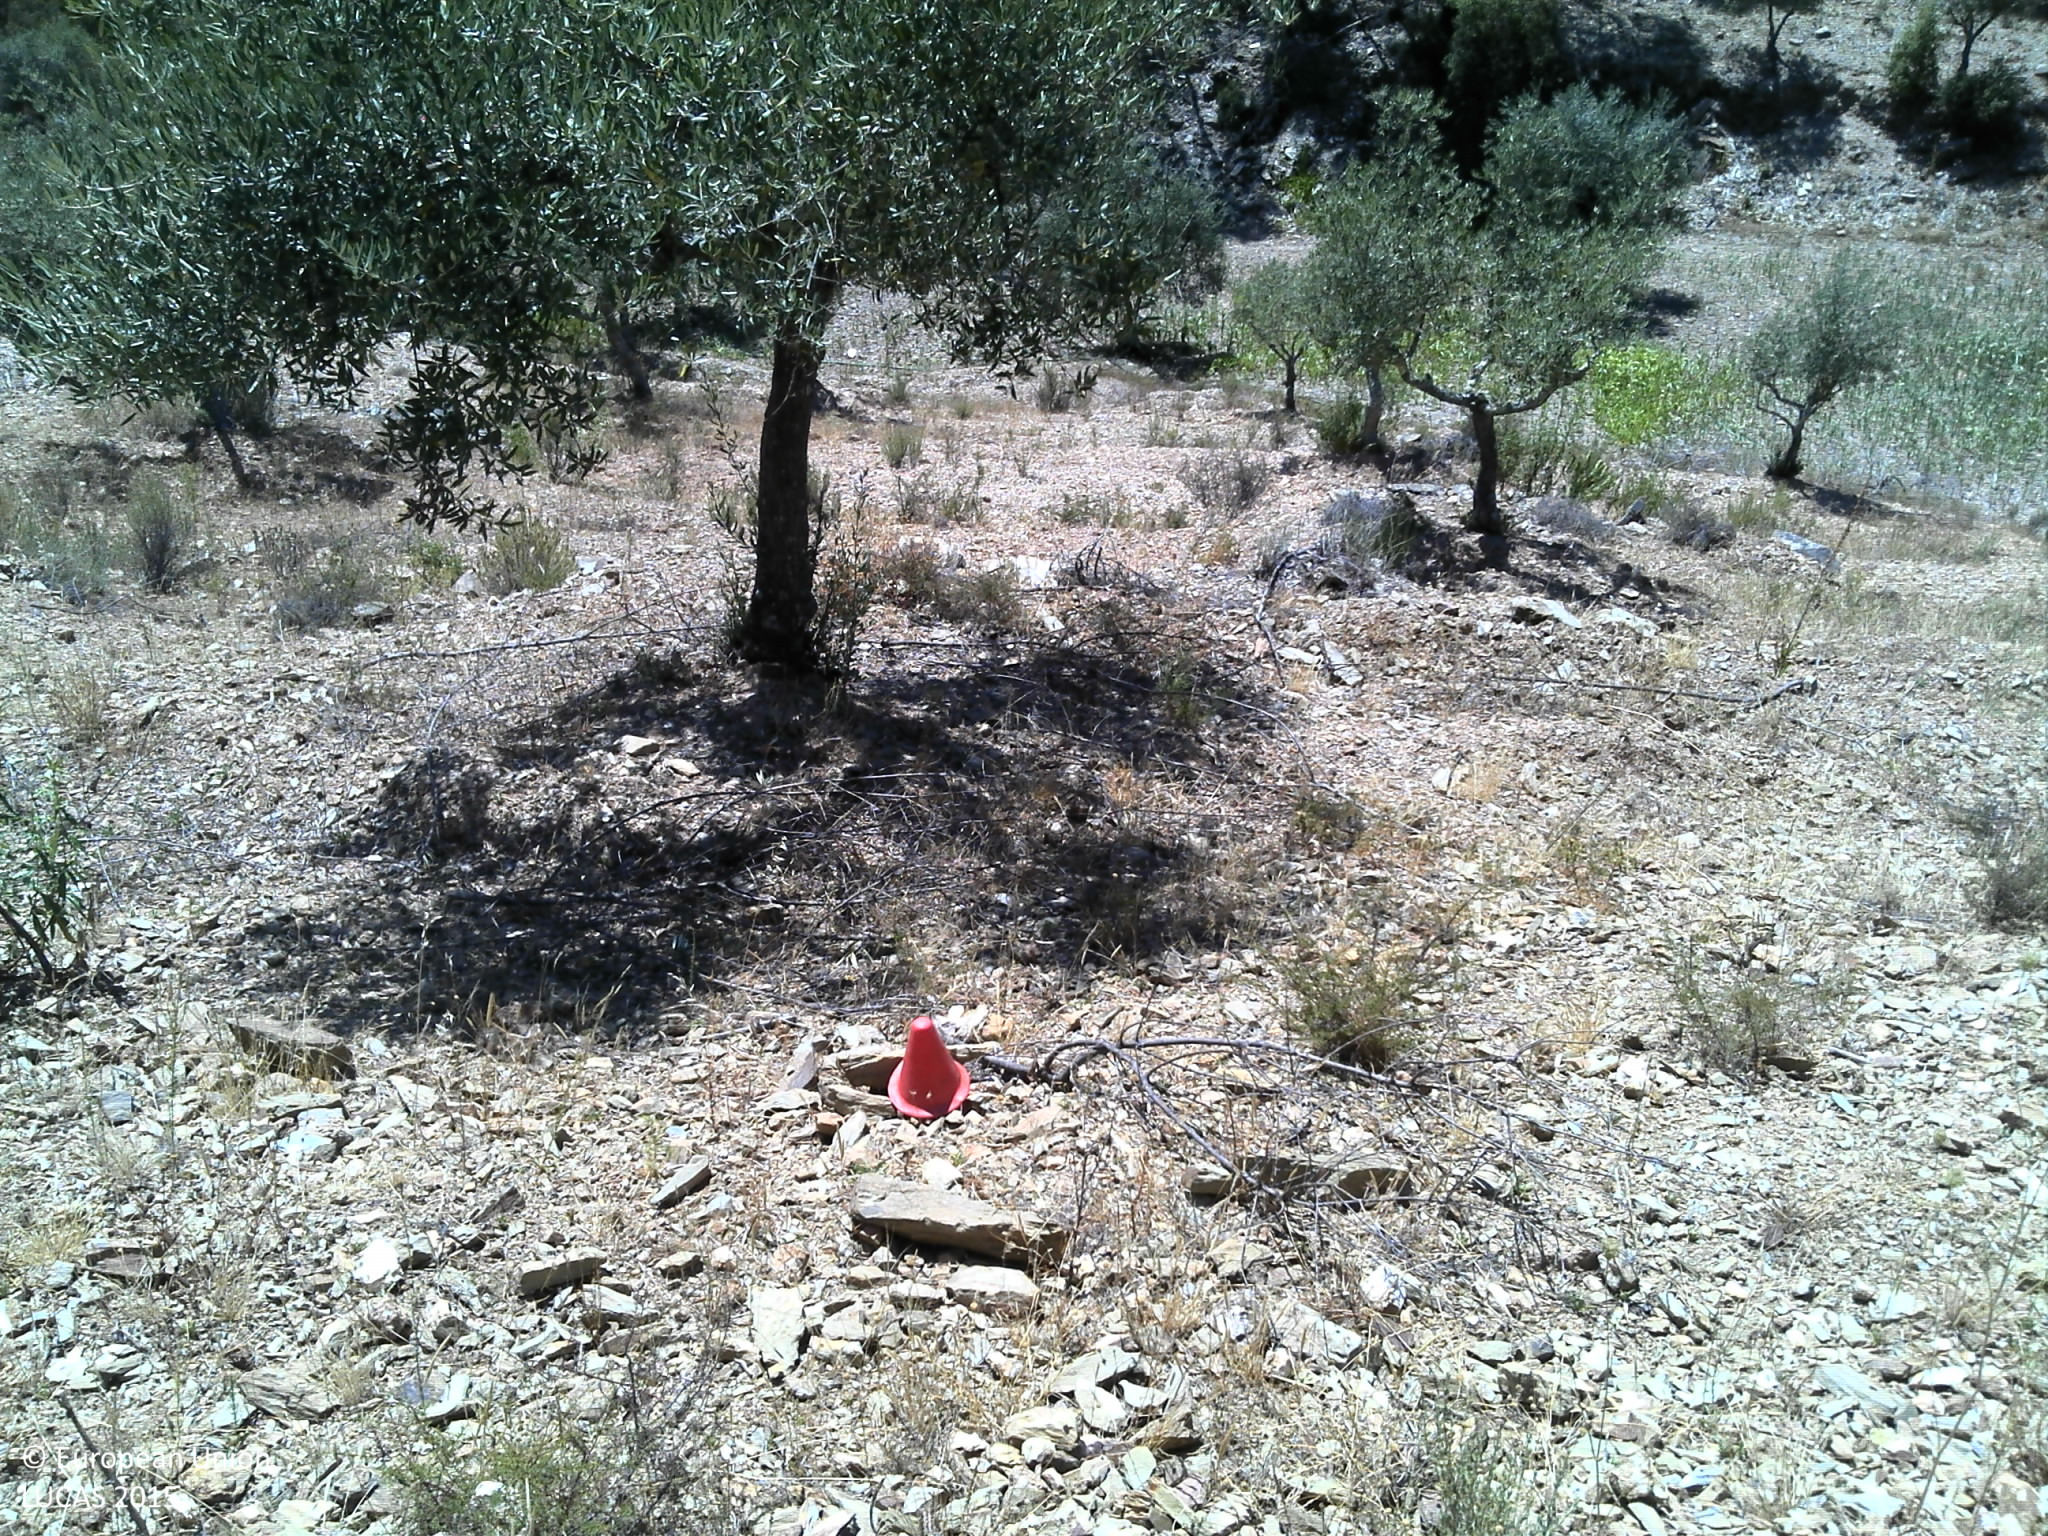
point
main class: Cropland
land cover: Olive groves
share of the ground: 10 - 25 %
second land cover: Shrubland without tree cover
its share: 10 - 25 %
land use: Agriculture (excluding fallow land and kitchen gardens)
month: July
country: PT
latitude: 39.6486
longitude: -7.7579
